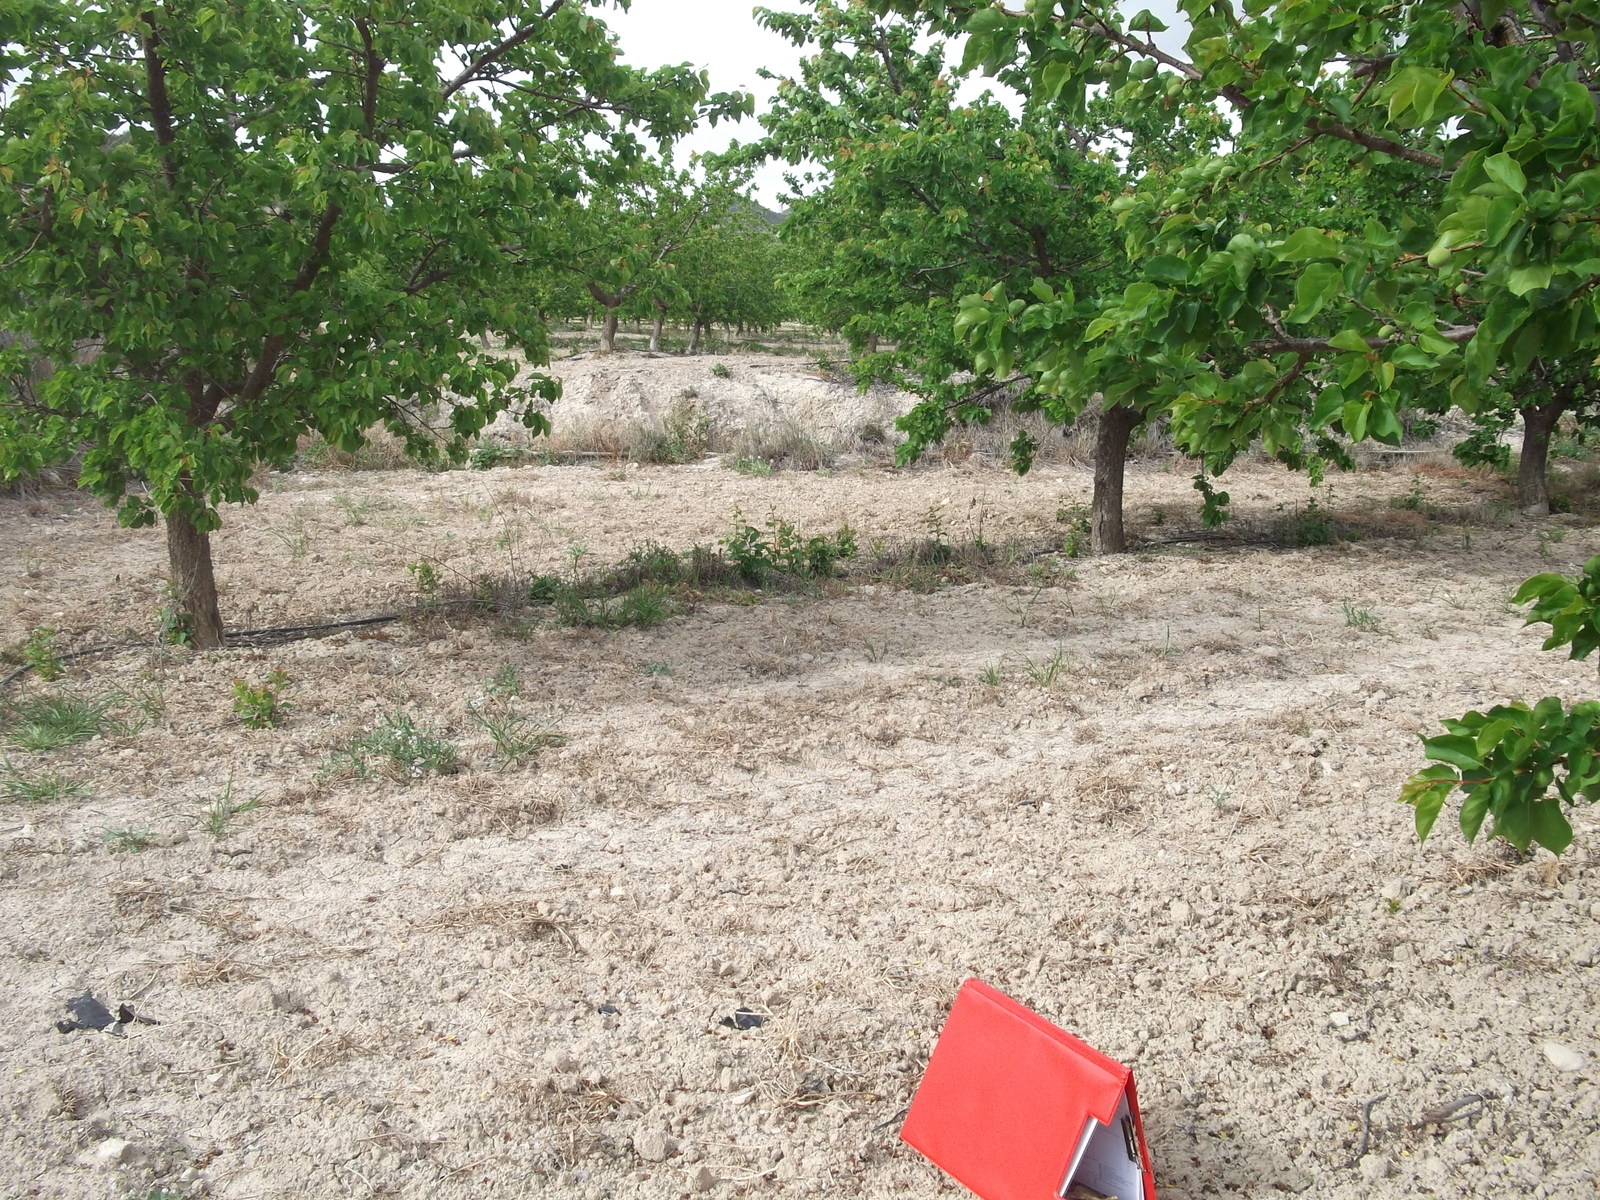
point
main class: Cropland
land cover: Other fruit trees and berries
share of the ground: 10 - 25 %
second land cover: Other bare soil
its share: > 75 %
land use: Agriculture (excluding fallow land and kitchen gardens)
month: April
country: ES
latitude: 38.0321
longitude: -1.5274
